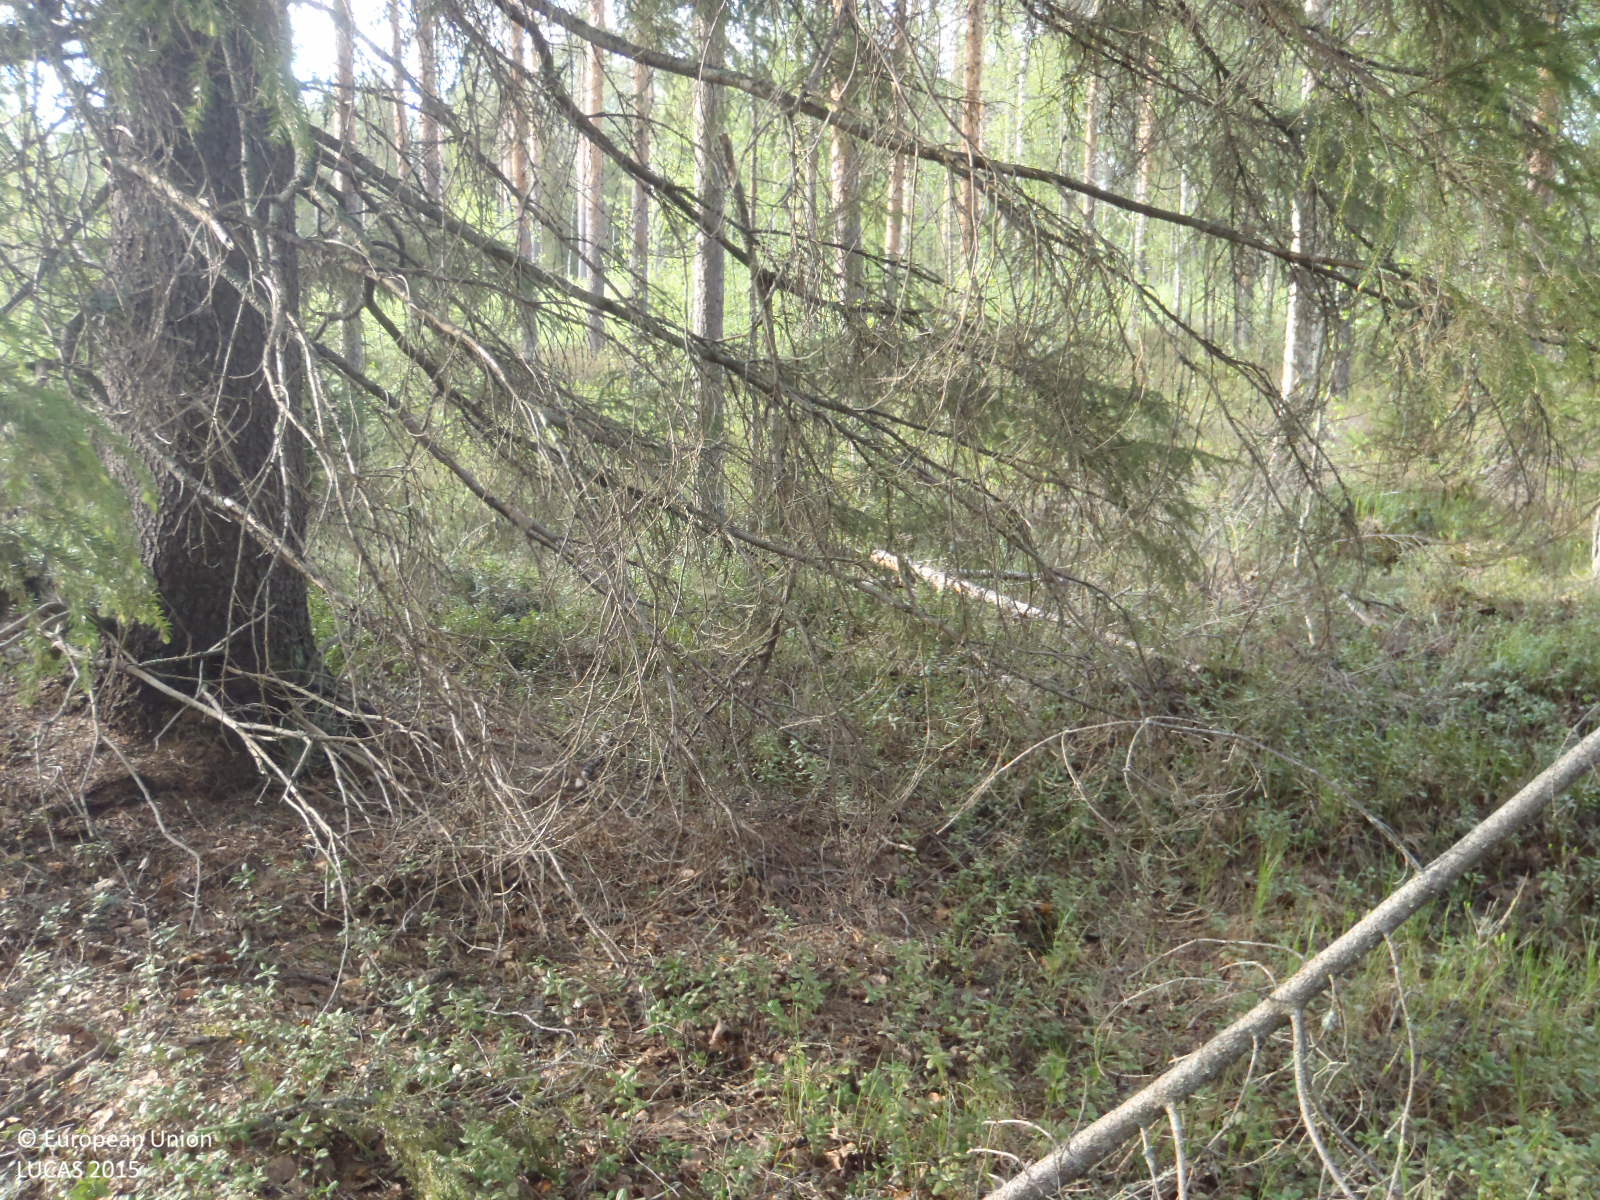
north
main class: Woodland
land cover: Other mixed woodland
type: boreal forest
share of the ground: > 75 %
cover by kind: coniferous forest trees 55 %, broadleaved forest trees 20 %, shrubs 20 %, lichens and mosses 5 %
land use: Forestry
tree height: > 5 m
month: June
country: FI
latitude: 65.0739
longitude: 25.6744
